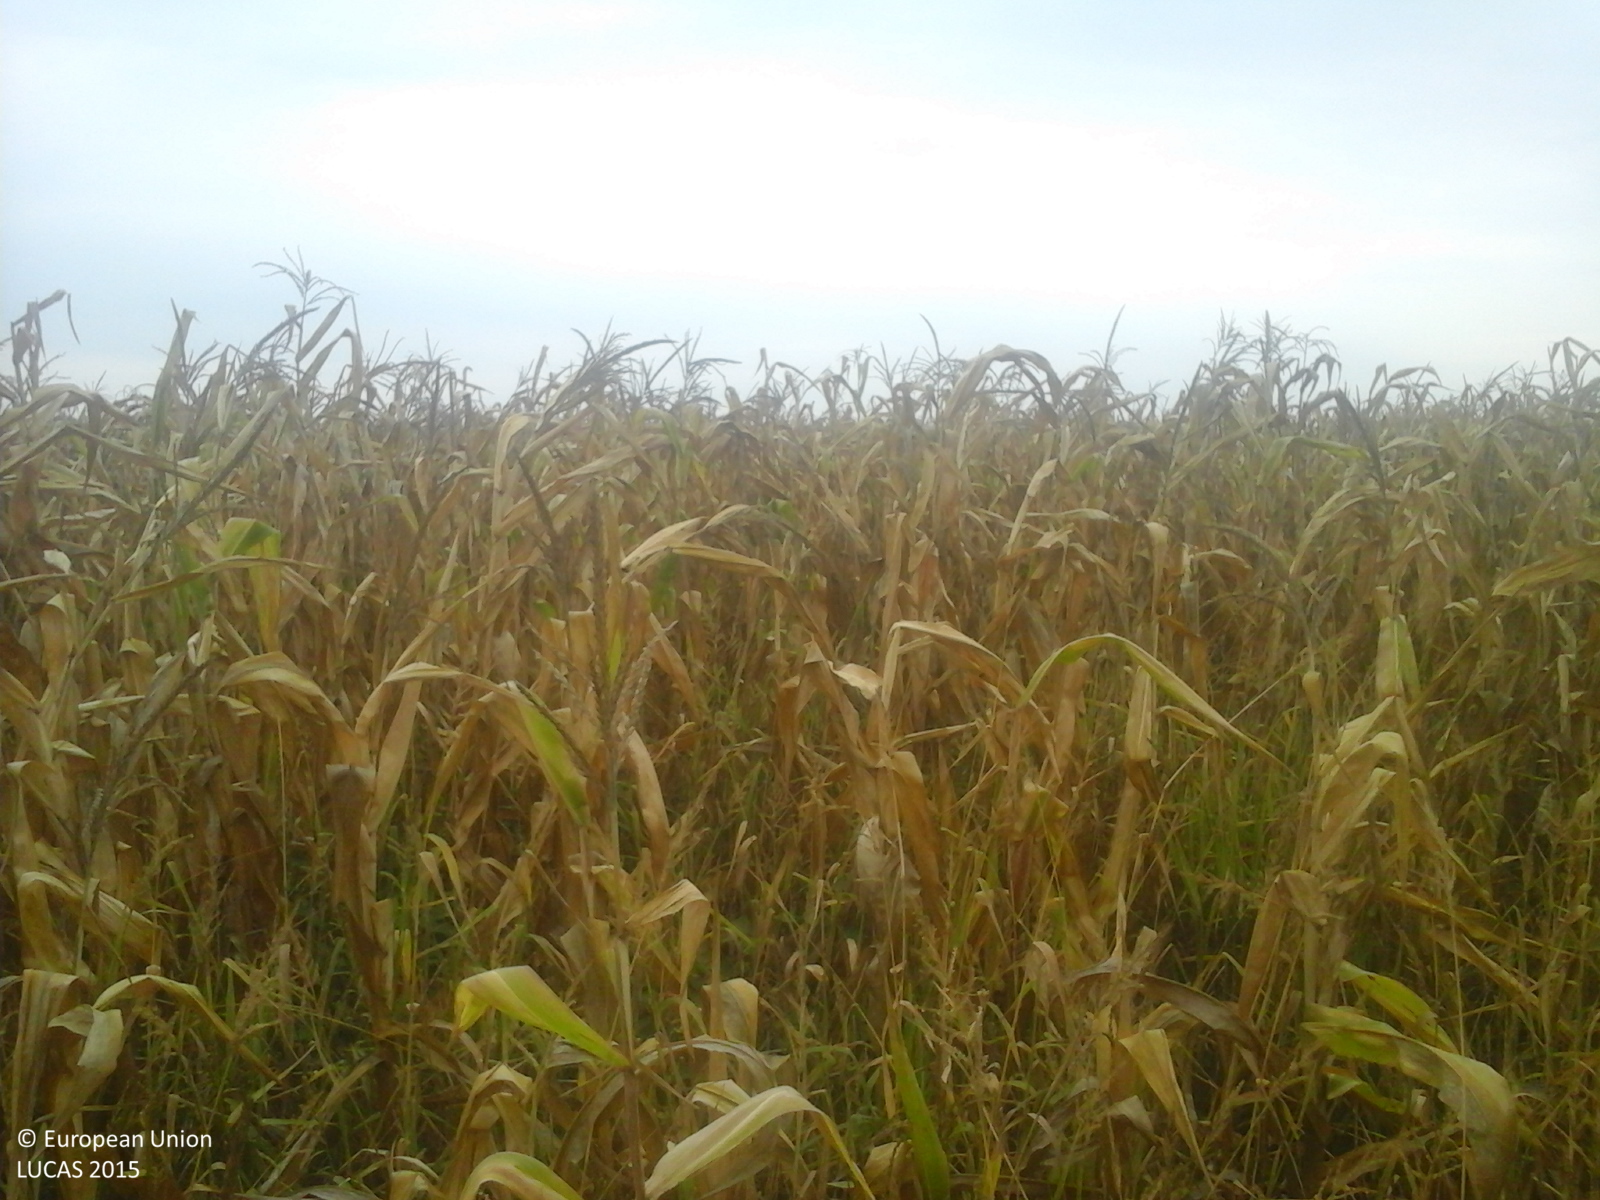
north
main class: Cropland
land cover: Maize
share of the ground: > 75 %
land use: Agriculture (excluding fallow land and kitchen gardens)
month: September
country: RO
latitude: 47.6323
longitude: 22.6905
